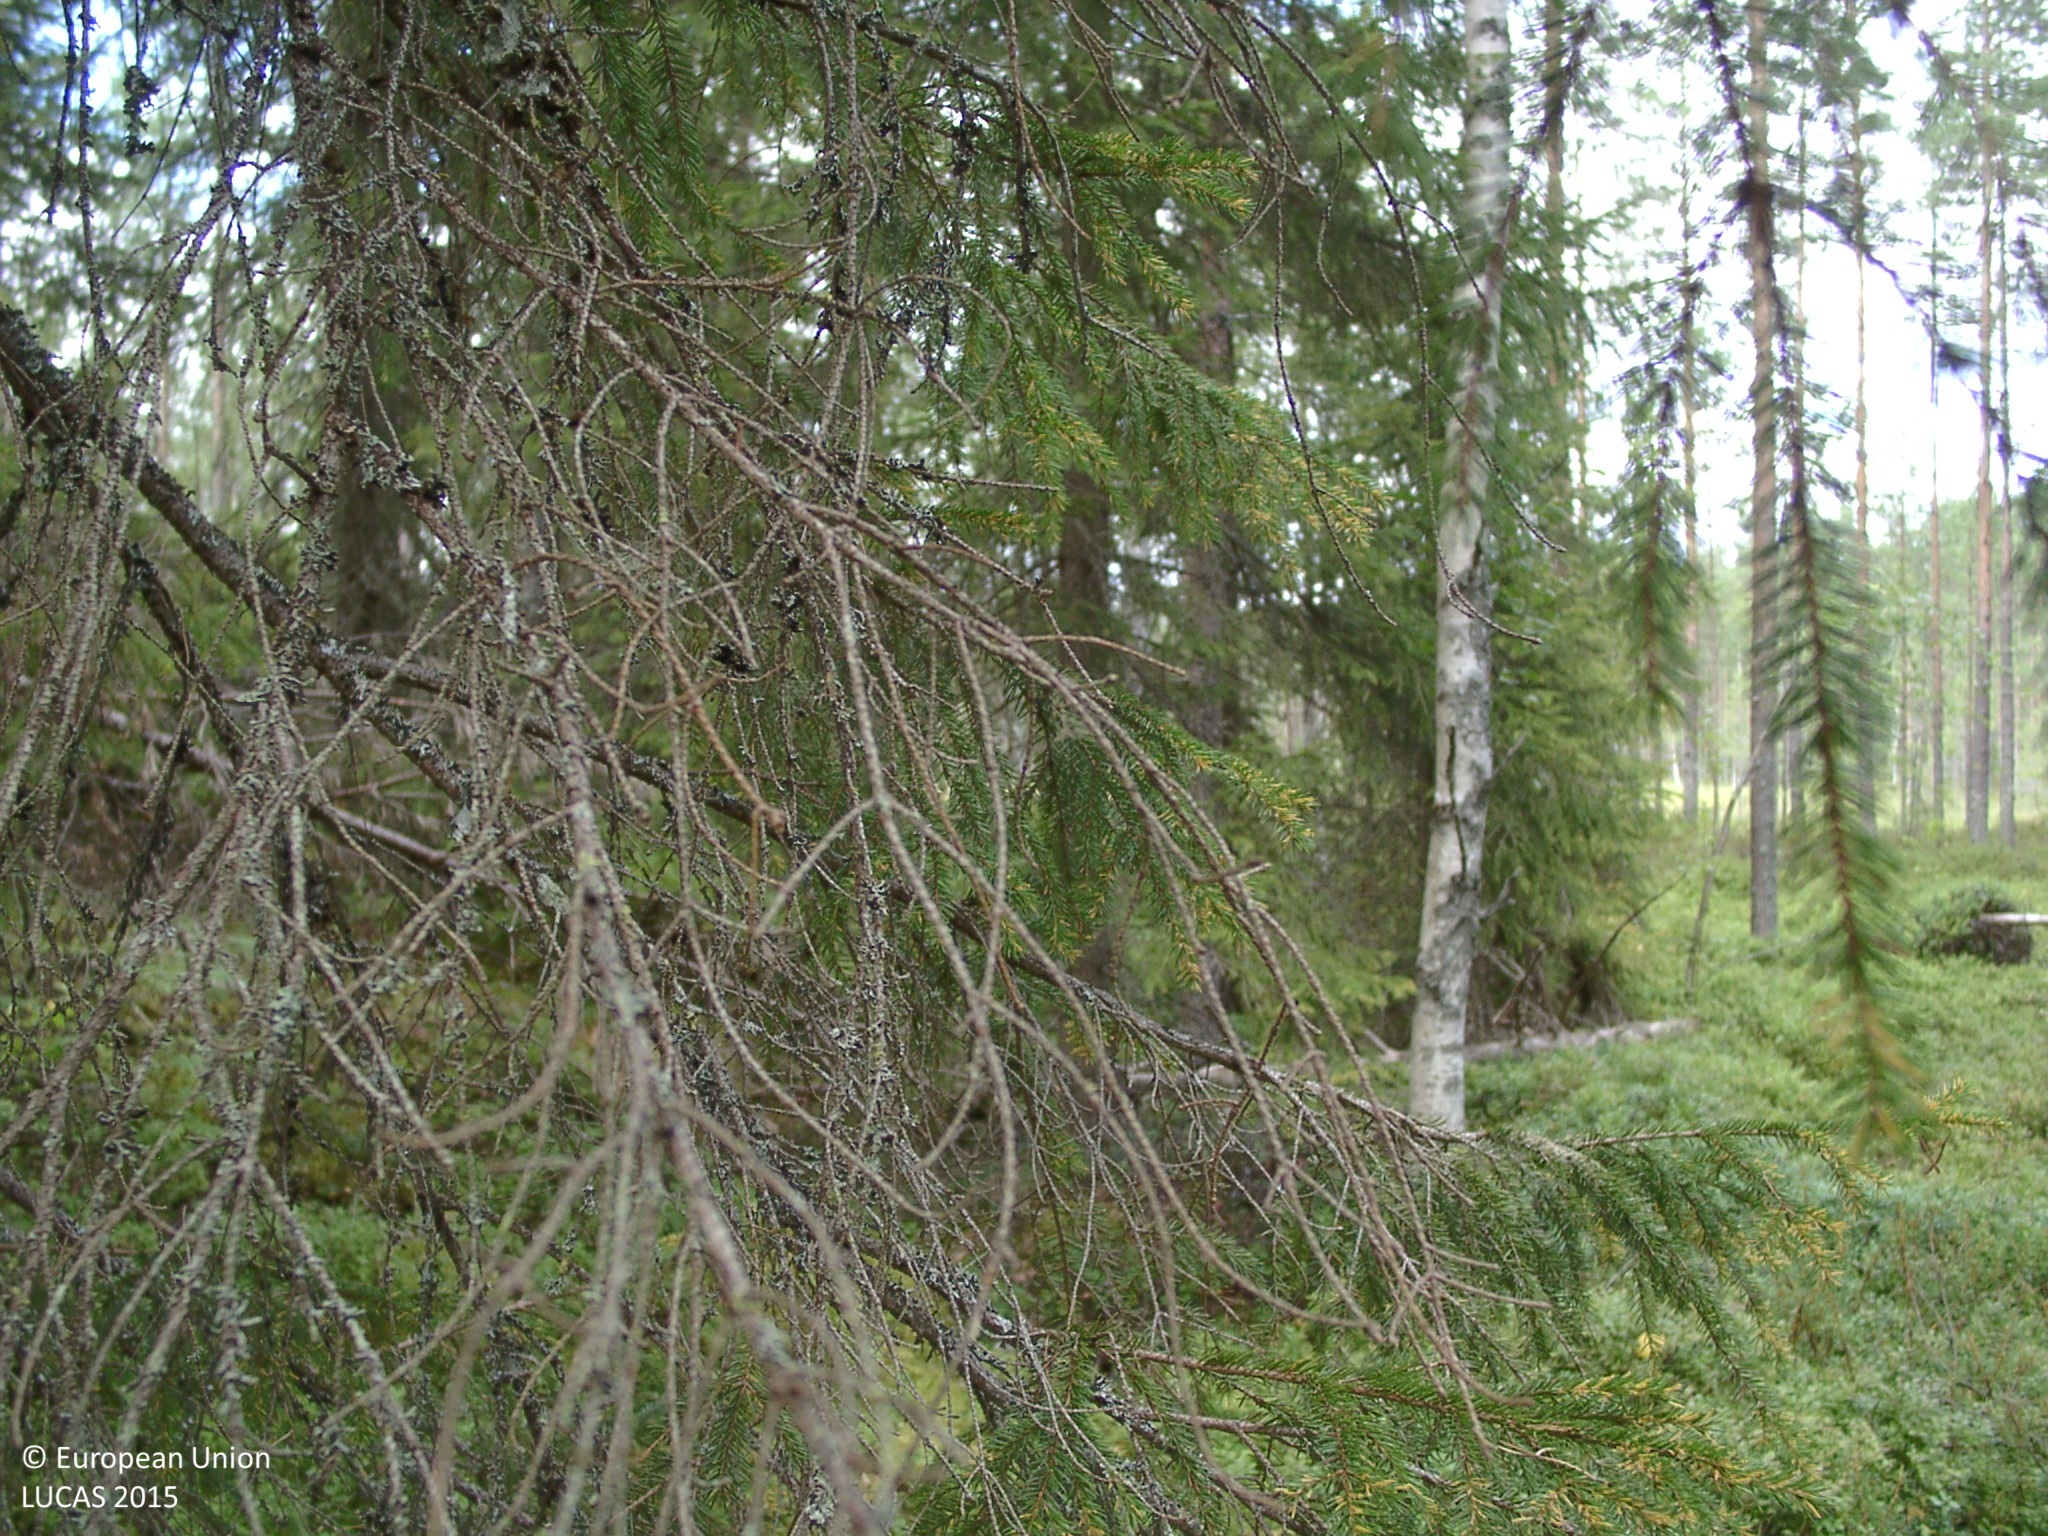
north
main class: Woodland
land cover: Other mixed woodland
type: boreal forest
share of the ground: 50 - 75 %
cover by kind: coniferous forest trees 50 %, broadleaved forest trees 20 %, shrubs 20 %, lichens and mosses 10 %
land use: Forestry
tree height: > 5 m
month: August
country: FI
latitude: 62.3935
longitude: 25.4908
